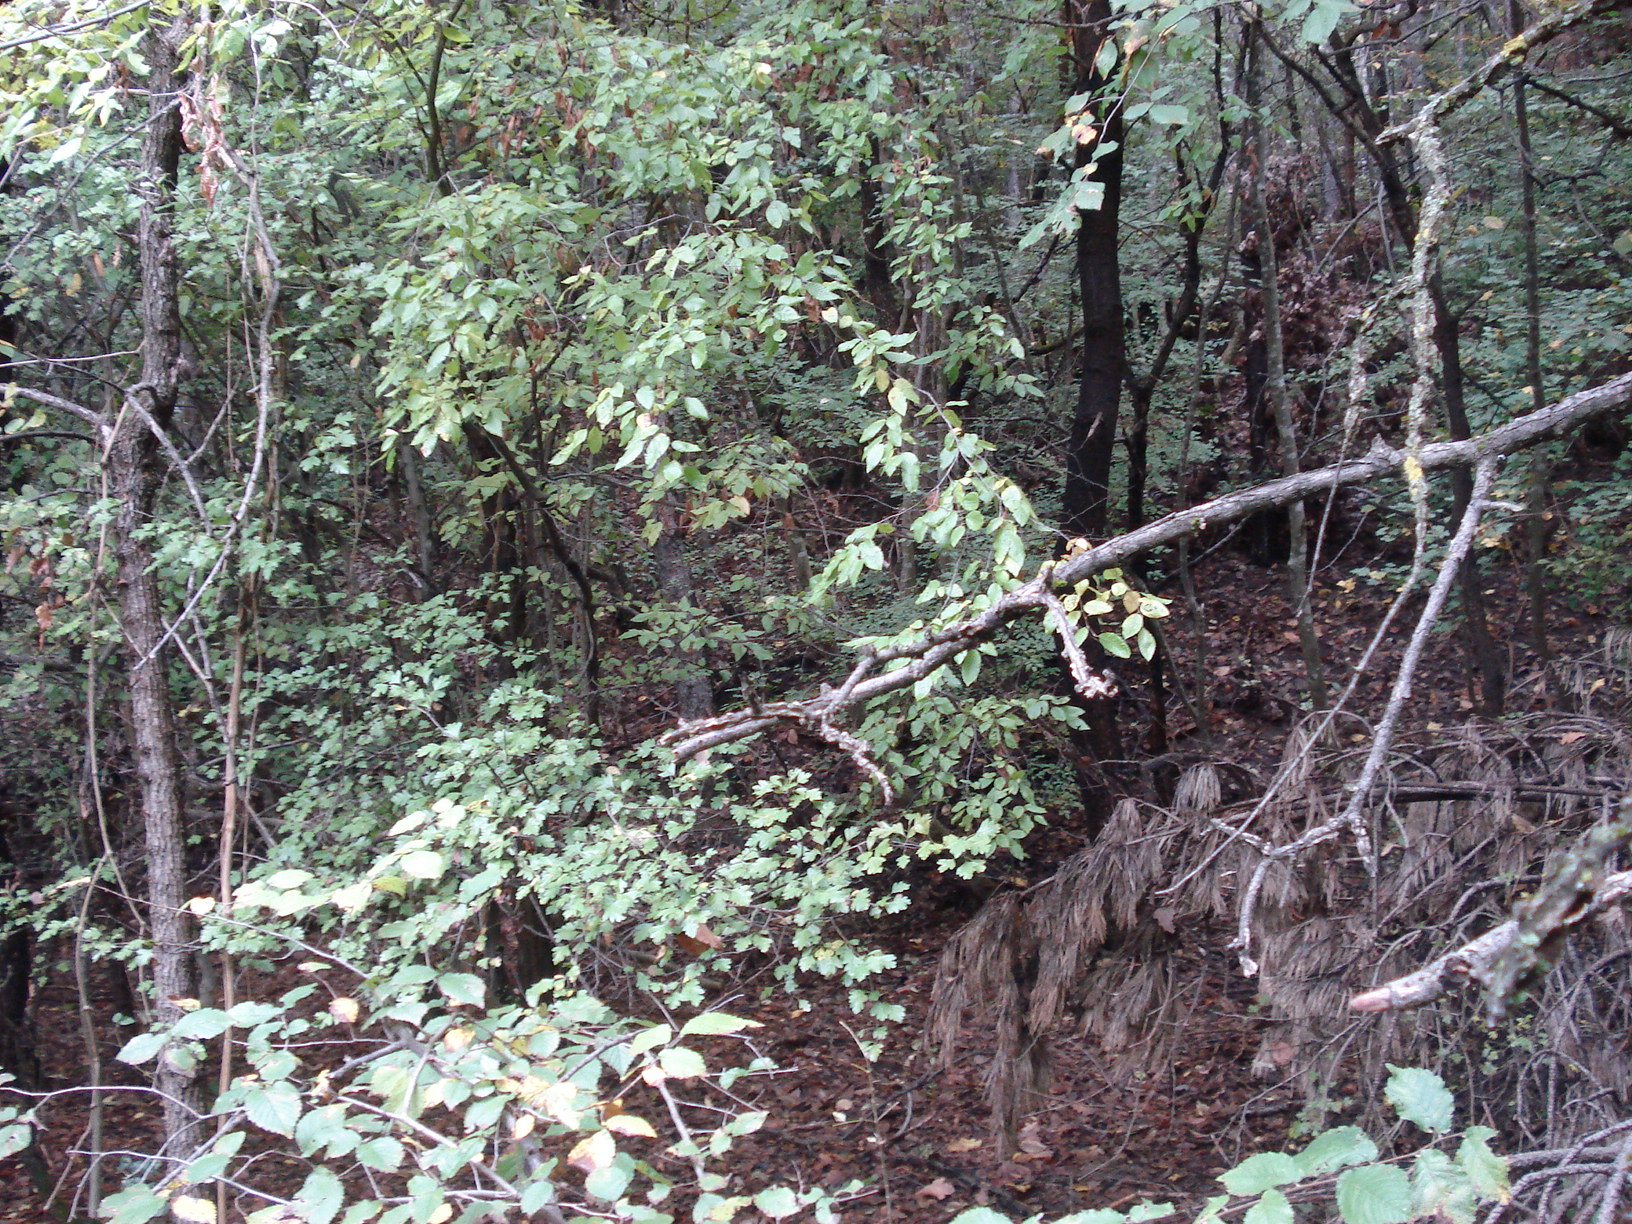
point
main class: Woodland
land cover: Broadleaved woodland
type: mesophytic deciduous forest
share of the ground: > 75 %
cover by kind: broadleaved forest trees 80 %, unconsolidated bare surface 10 %, shrubs 5 %, herbaceous plants 5 %
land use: Forestry
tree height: > 5 m
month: October
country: BG
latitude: 43.0857
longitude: 25.9702
